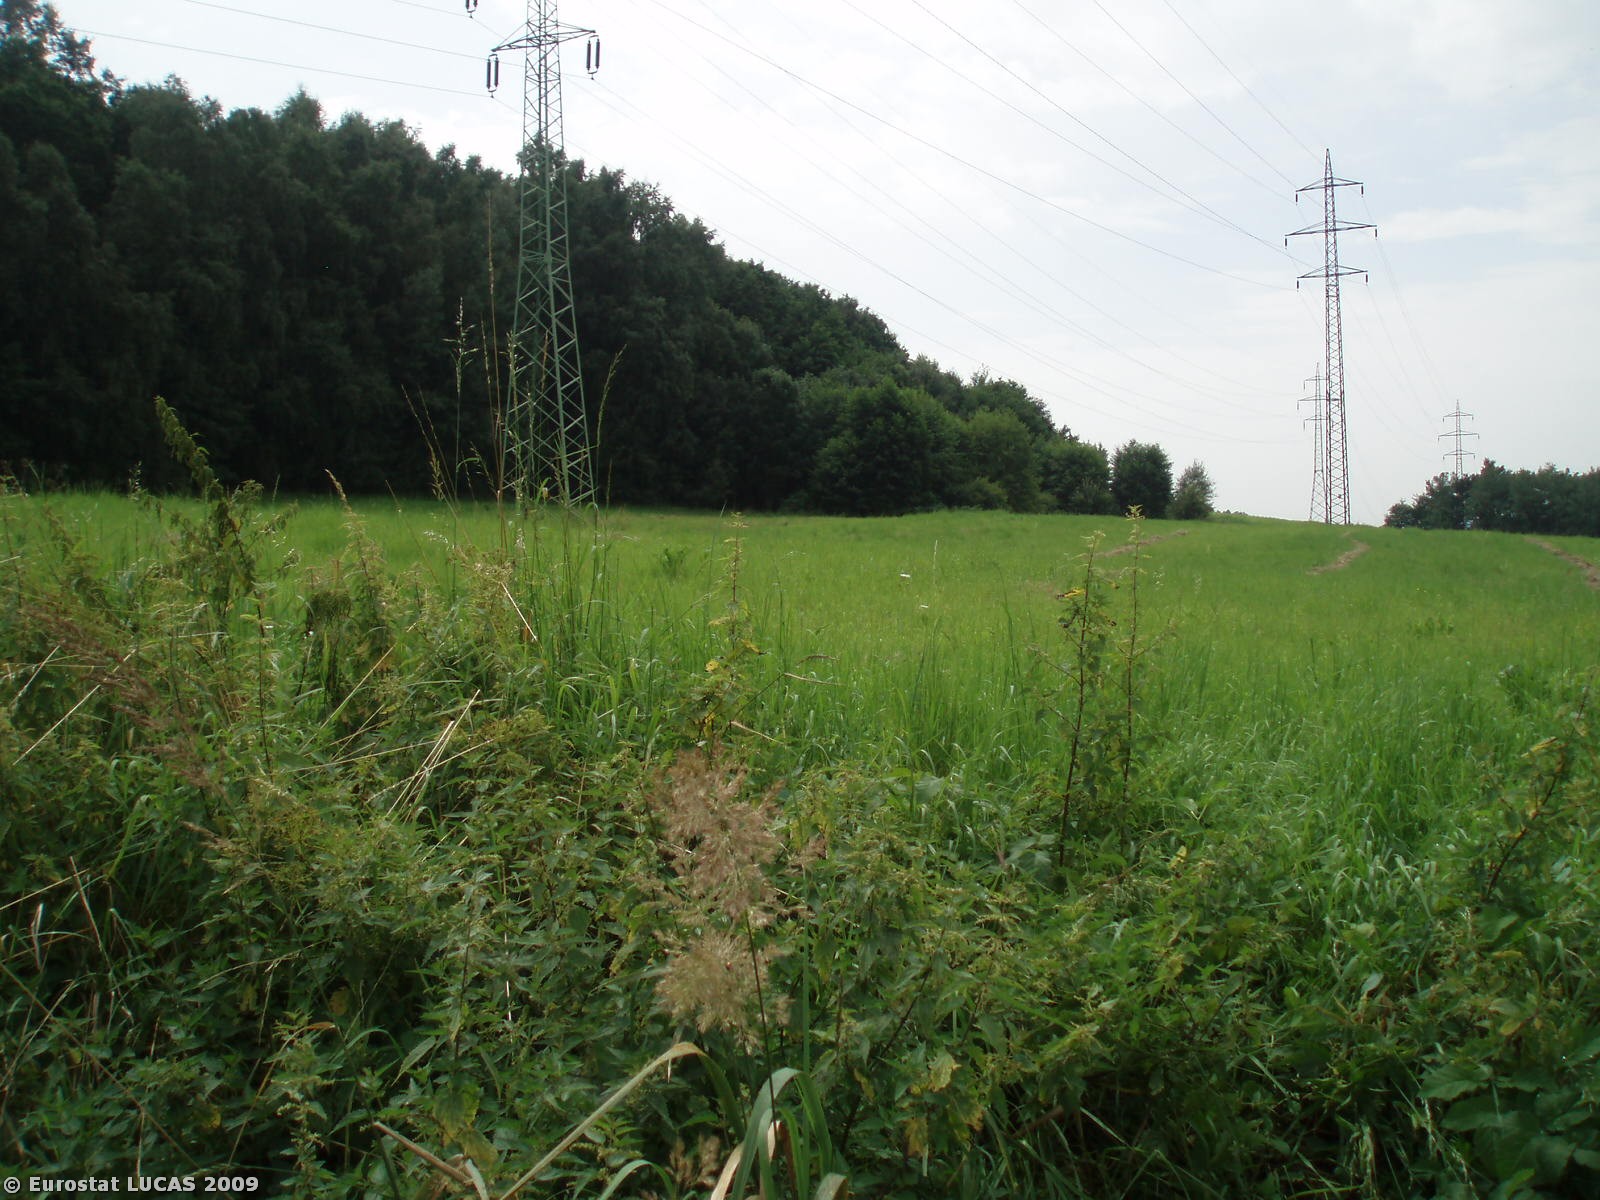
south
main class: Cropland
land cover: Pear fruit
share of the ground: 50 - 75 %
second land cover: Grassland with sparse tree/shrub cover
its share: > 75 %
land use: Agriculture (excluding fallow land and kitchen gardens)
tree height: > 5 m
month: July
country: CZ
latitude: 50.7547
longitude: 14.2113
